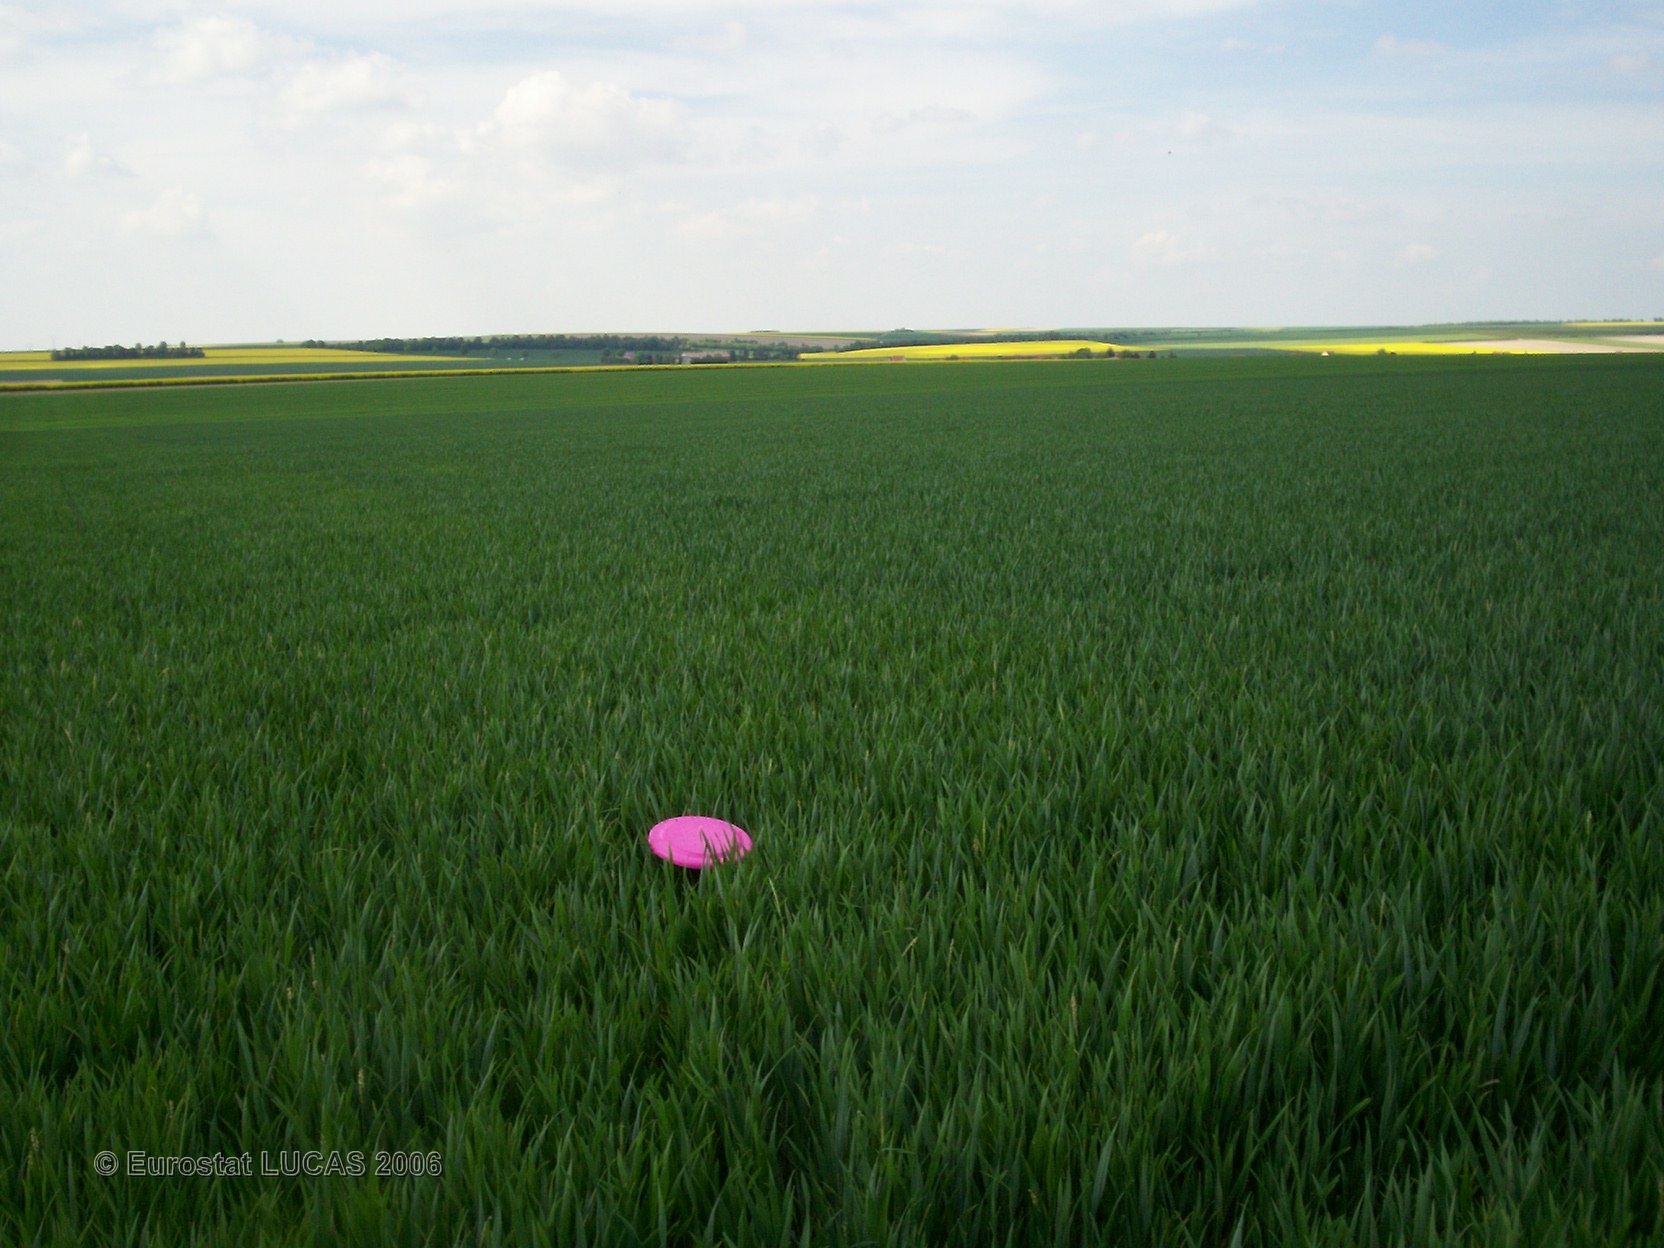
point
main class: Cropland
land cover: Common wheat
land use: Agriculture (excluding fallow land and kitchen gardens)
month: May
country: FR
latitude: 48.9143
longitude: 4.4703
